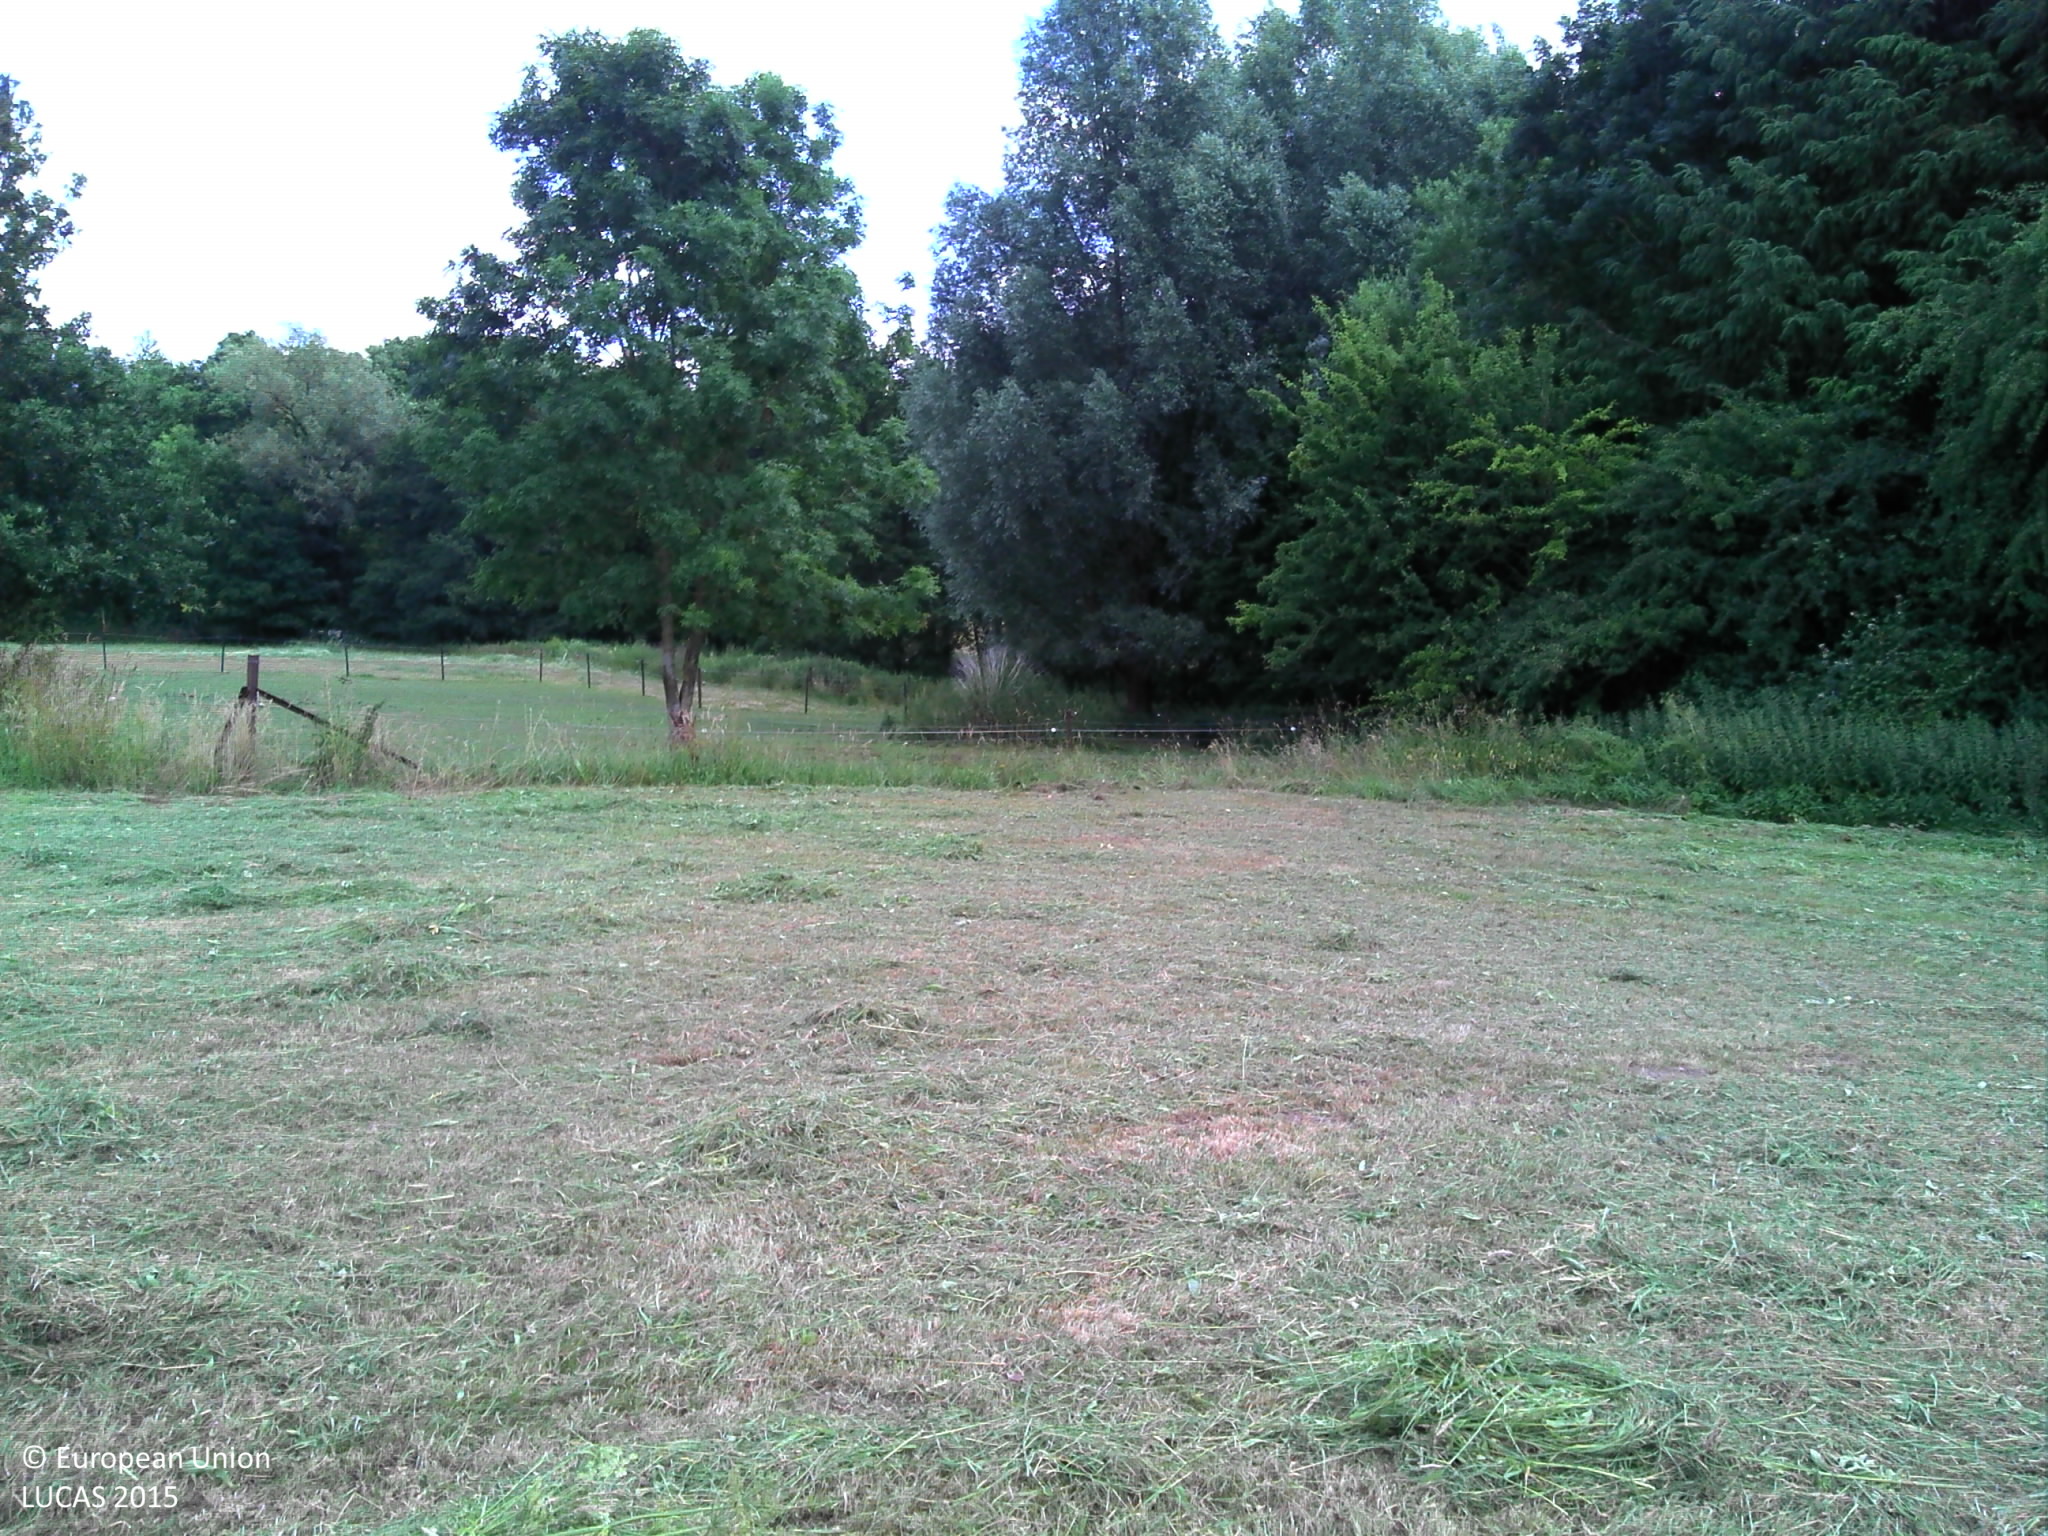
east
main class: Grassland
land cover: Grassland without tree/shrub cover
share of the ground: > 75 %
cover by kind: herbaceous plants 100 %
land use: Agriculture (excluding fallow land and kitchen gardens)
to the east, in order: Grassland without tree/shrub cover; Fences; Grassland without tree/shrub cover; Fences; Grassland without tree/shrub cover; Fences; Spontaneously vegetated surfaces; Broadleaved woodland; Rivers and streams; Broadleaved woodland; Tracks; Broadleaved woodland; Grassland without tree/shrub cover; Common wheat; Electric lines
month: July
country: BE
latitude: 50.2557
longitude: 4.6243
